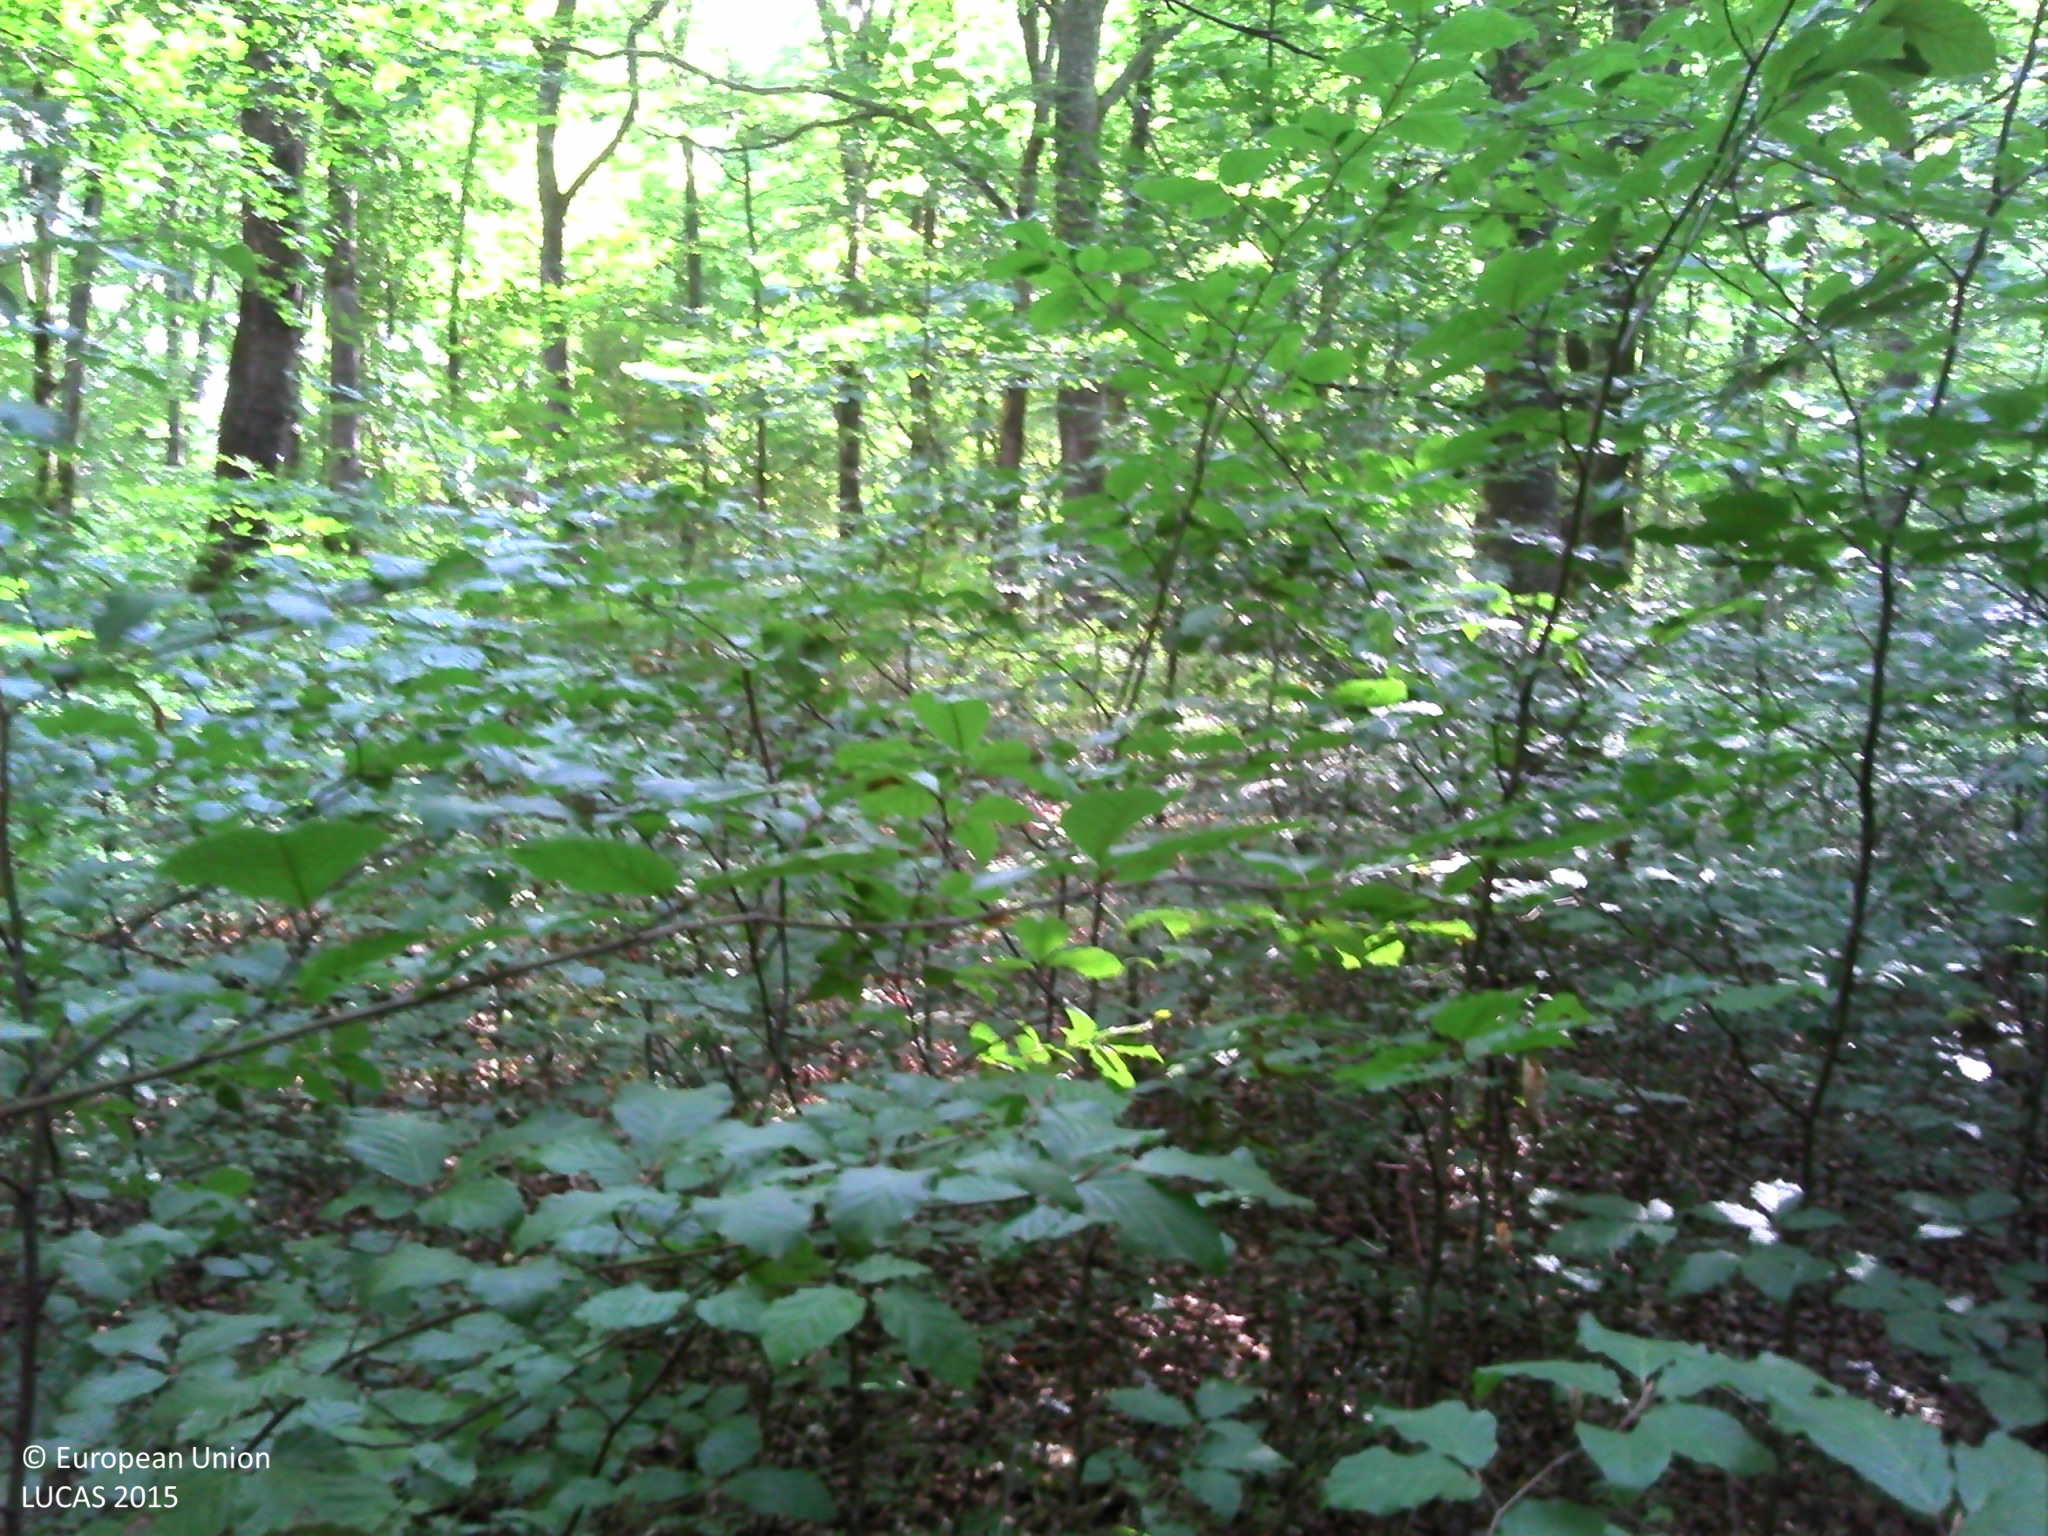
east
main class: Woodland
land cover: Broadleaved woodland
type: mesophytic deciduous forest
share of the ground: > 75 %
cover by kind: broadleaved forest trees 90 %, herbaceous plants 5 %, lichens and mosses 5 %
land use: Forestry
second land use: Amenities, museums, leisure
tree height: > 5 m
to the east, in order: Broadleaved woodland; Tracks; Broadleaved woodland; Grassland without tree/shrub cover
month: August
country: FR
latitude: 47.8638
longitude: 4.7454
